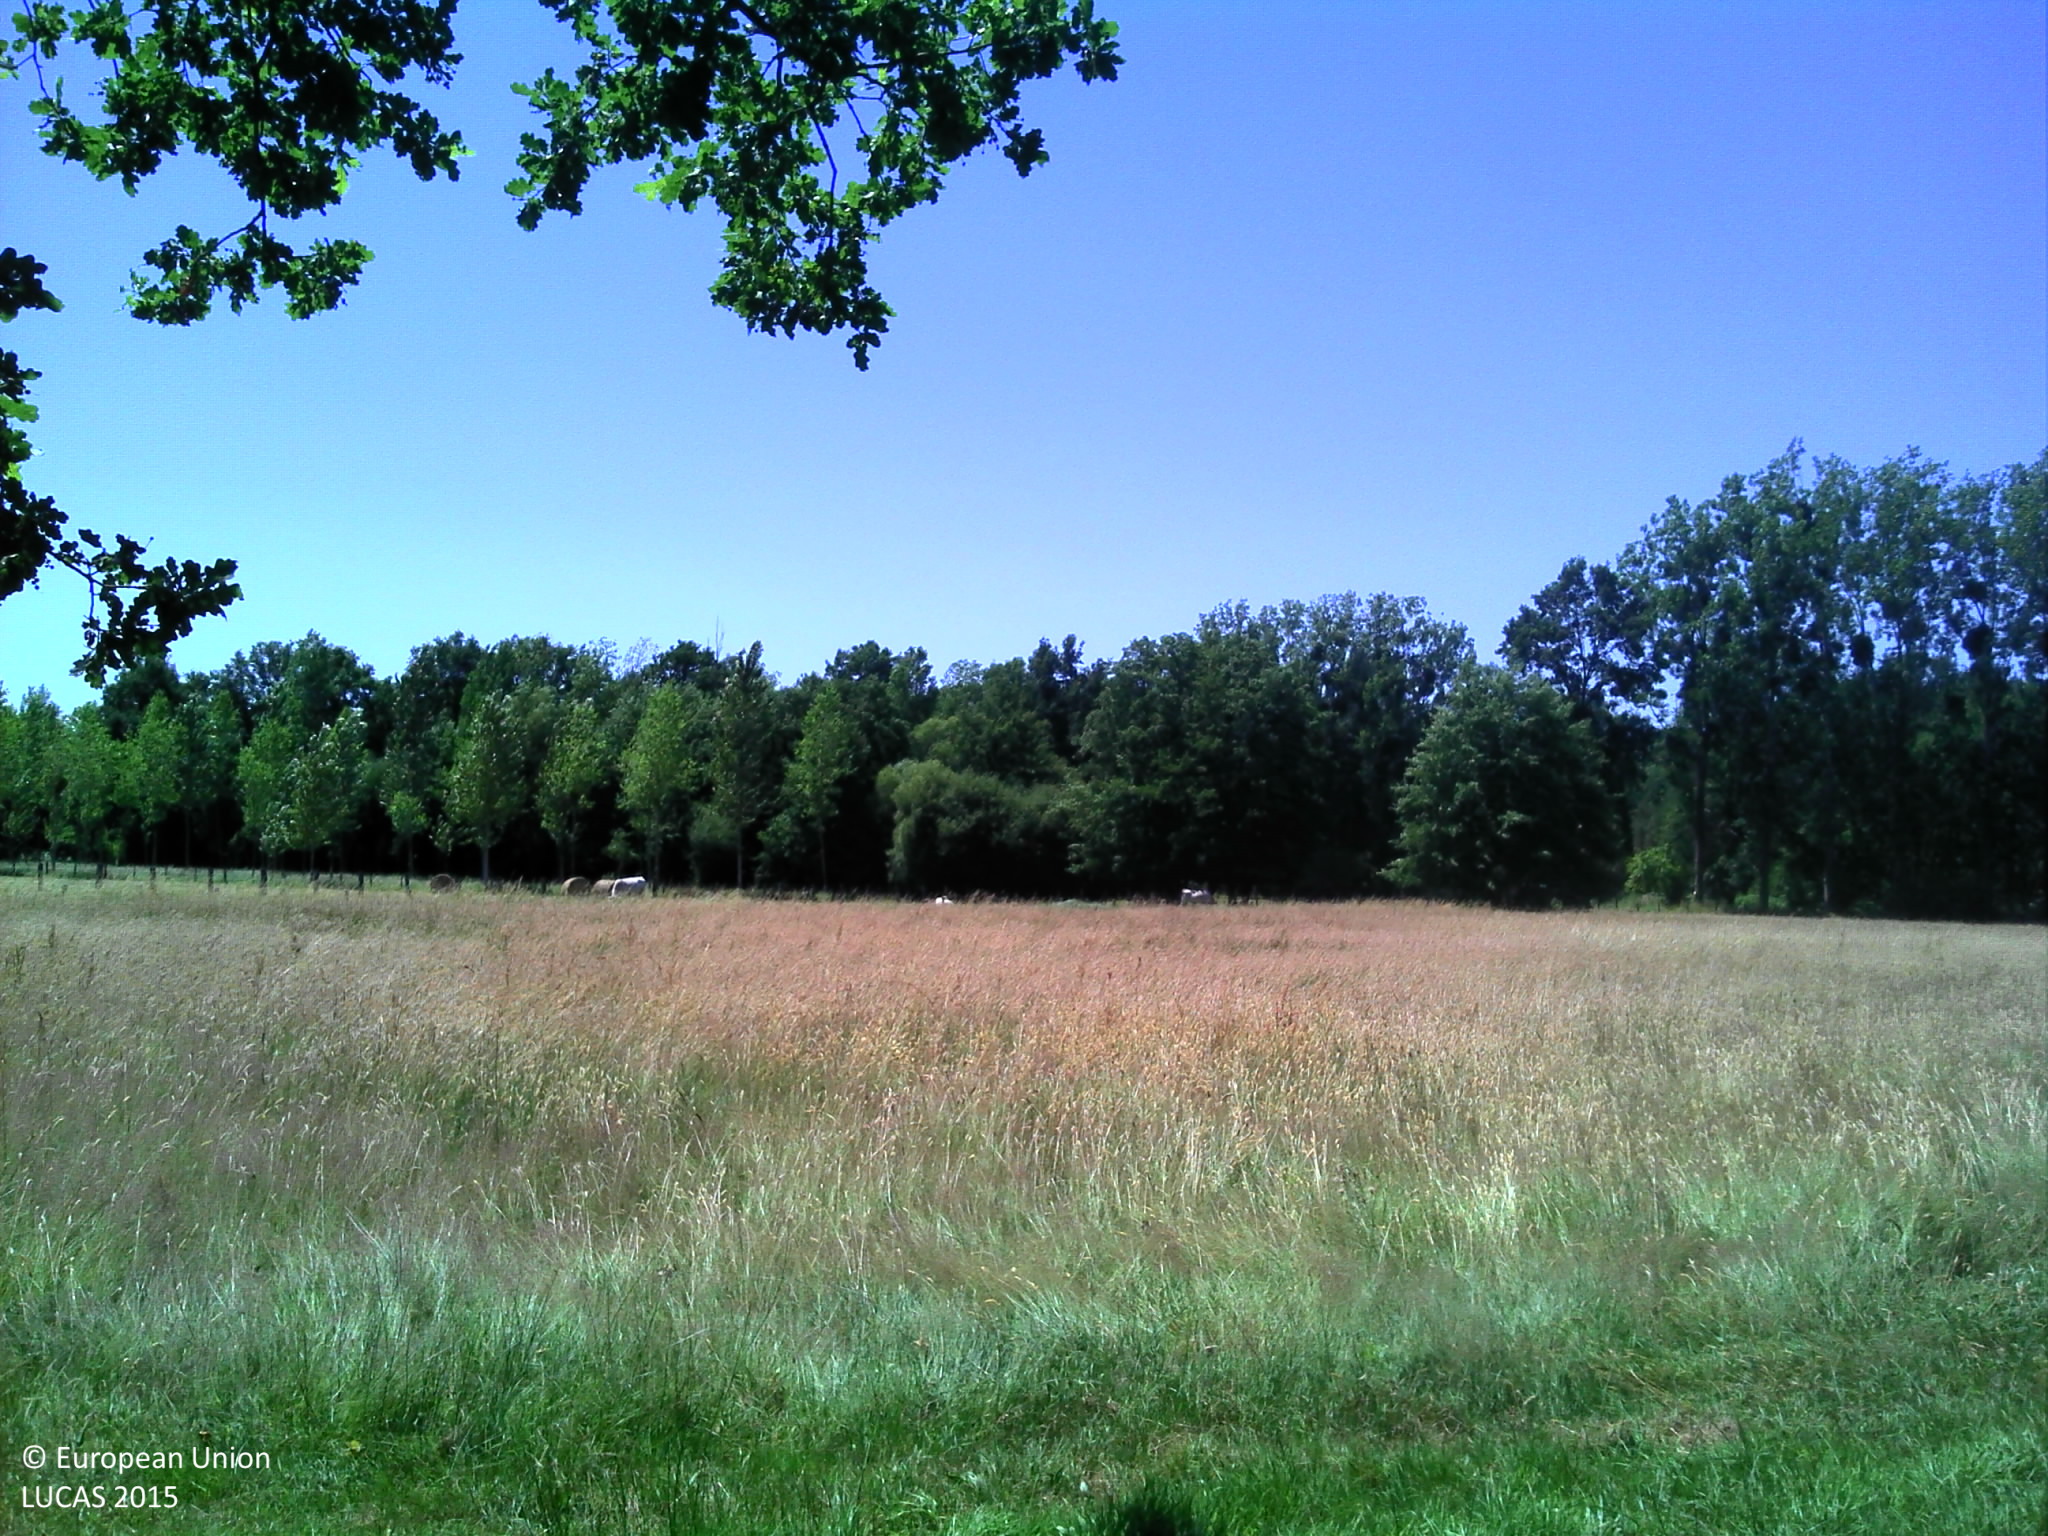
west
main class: Grassland
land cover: Grassland without tree/shrub cover
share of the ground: > 75 %
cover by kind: herbaceous plants 100 %
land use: Agriculture (excluding fallow land and kitchen gardens)
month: June
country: FR
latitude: 47.9573
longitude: 0.2929
